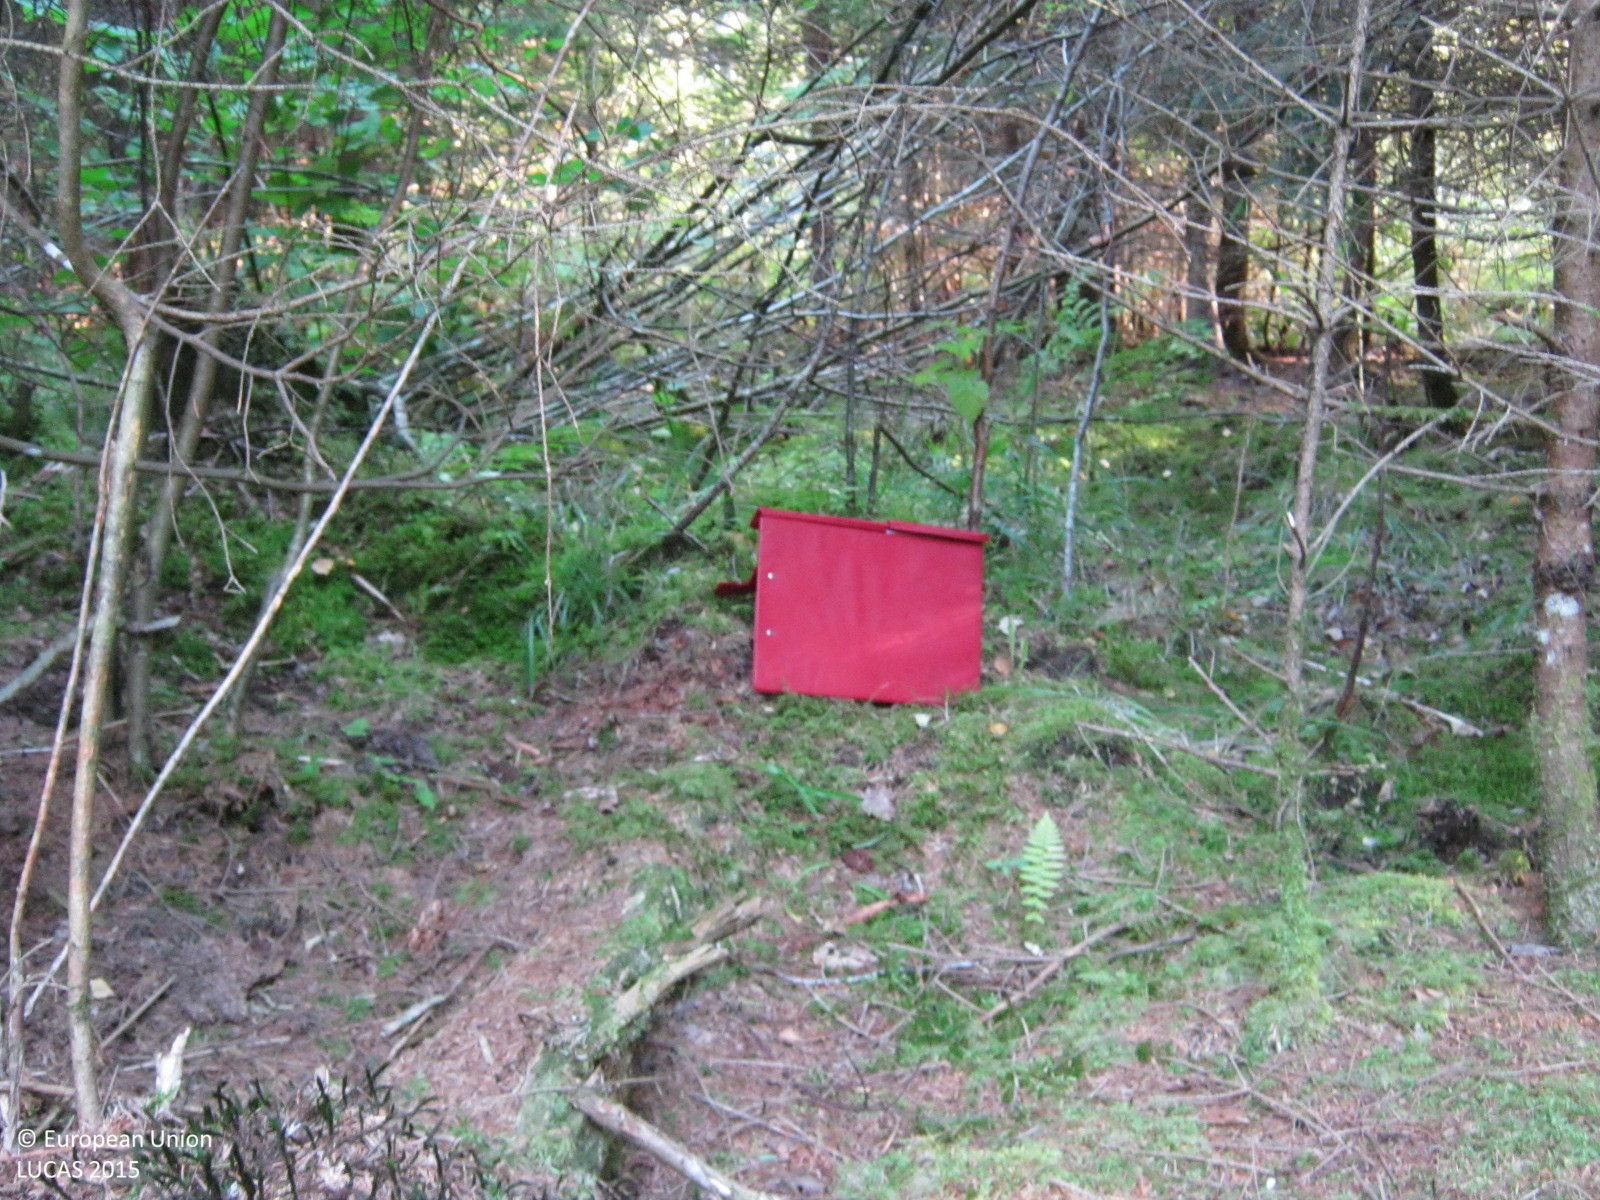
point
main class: Woodland
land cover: Spruce dominated coniferous woodland
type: hemiboreal forest and nemoral coniferous forest and mixed broadleaved-coniferous forest
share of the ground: > 75 %
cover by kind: coniferous forest trees 90 %, herbaceous plants 5 %, lichens and mosses 5 %
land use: Forestry
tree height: > 5 m
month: September
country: LV
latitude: 57.2929
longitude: 24.7158
